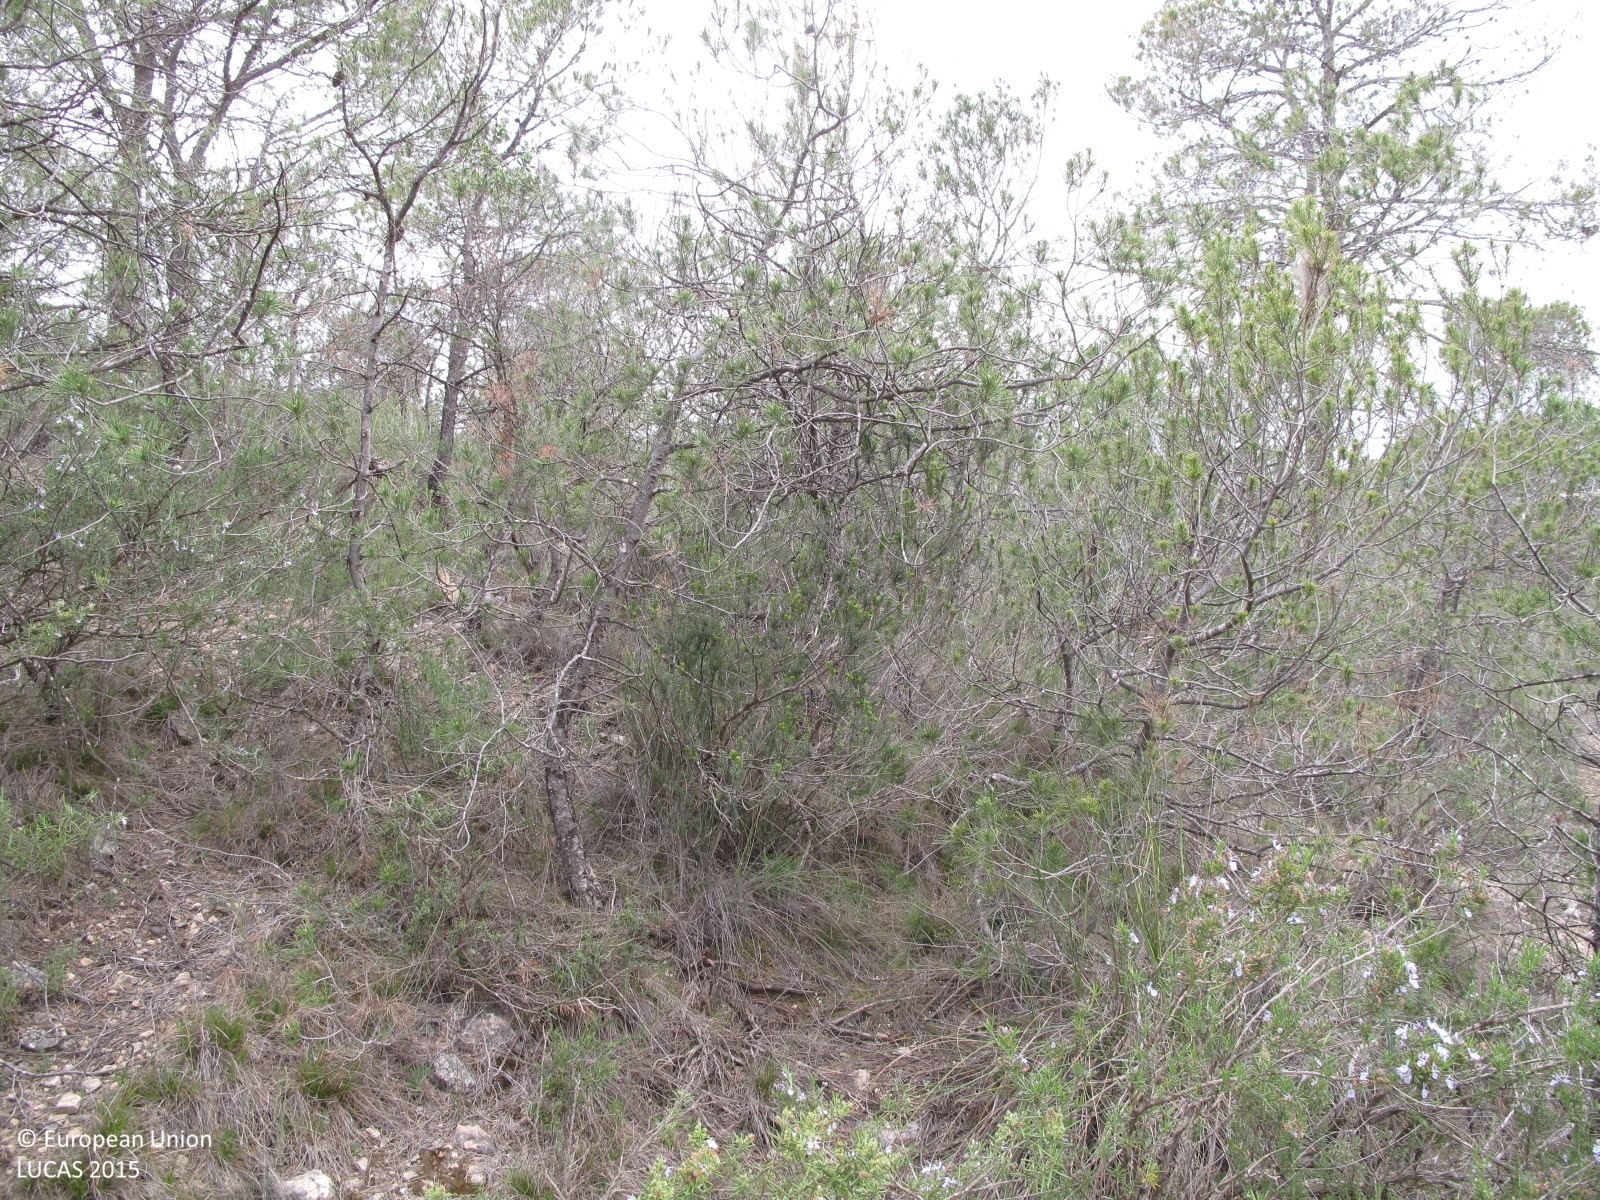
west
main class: Woodland
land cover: Pine dominated coniferous woodland
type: coniferous forest of the mediterranean region
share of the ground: 50 - 75 %
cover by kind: coniferous forest trees 60 %, shrubs 20 %, herbaceous plants 20 %
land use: Semi-natural and natural areas not in use
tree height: > 5 m
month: April
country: ES
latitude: 38.6111
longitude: -0.9577
